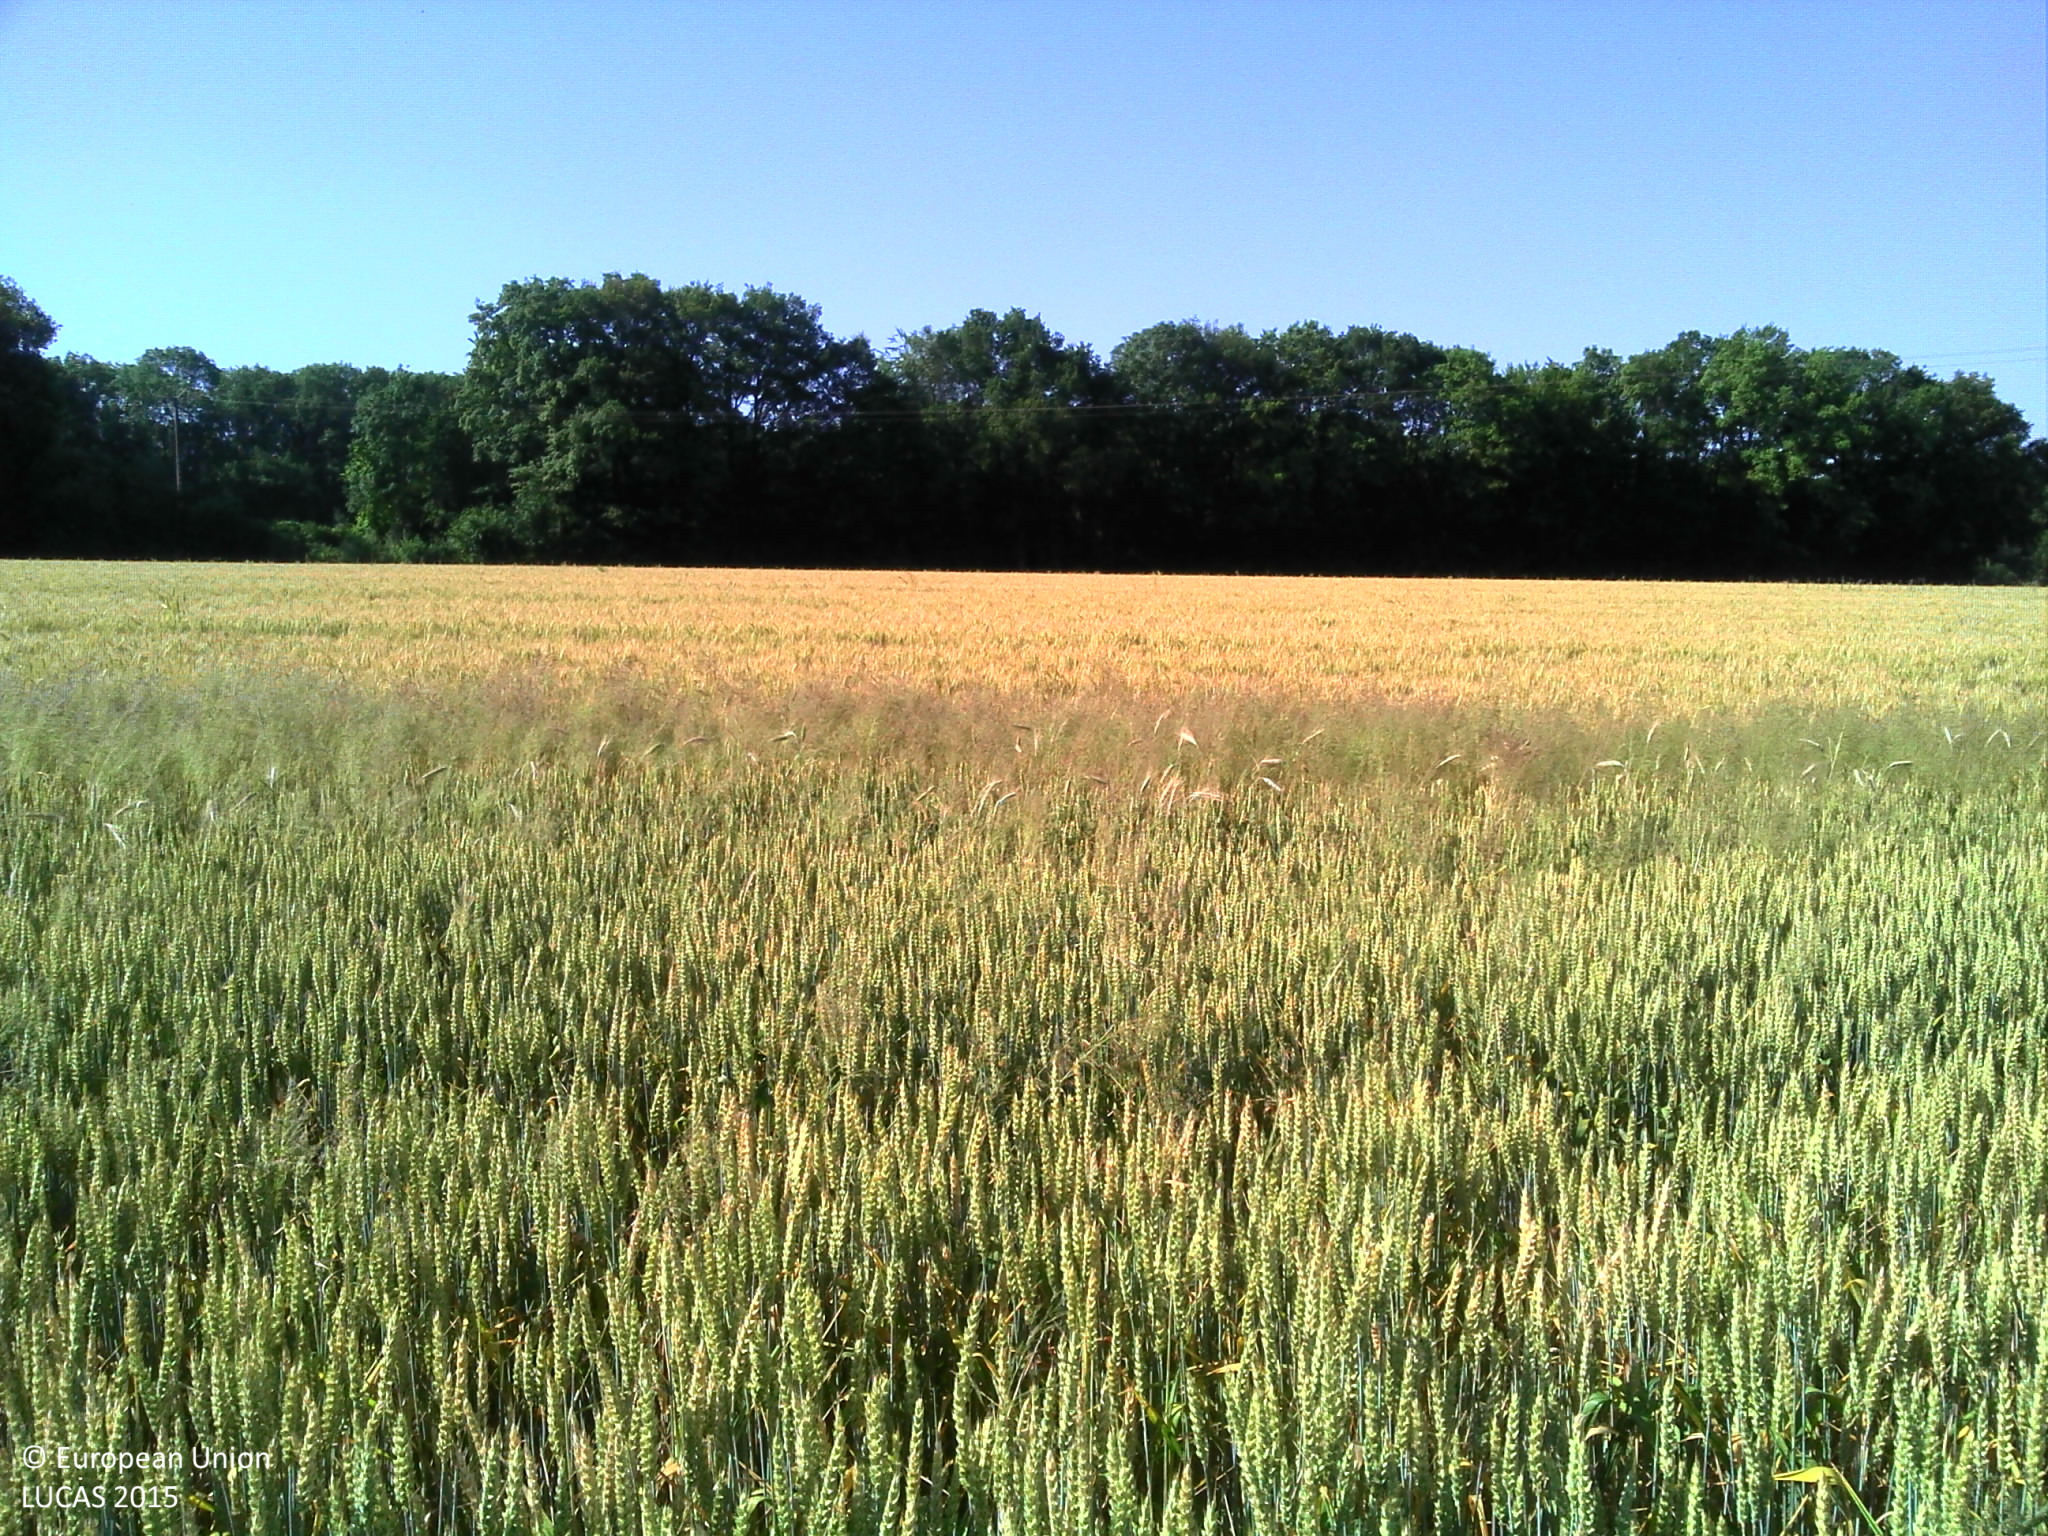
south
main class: Cropland
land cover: Common wheat
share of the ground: > 75 %
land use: Agriculture (excluding fallow land and kitchen gardens)
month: July
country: FR
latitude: 48.5739
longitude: 6.2459
